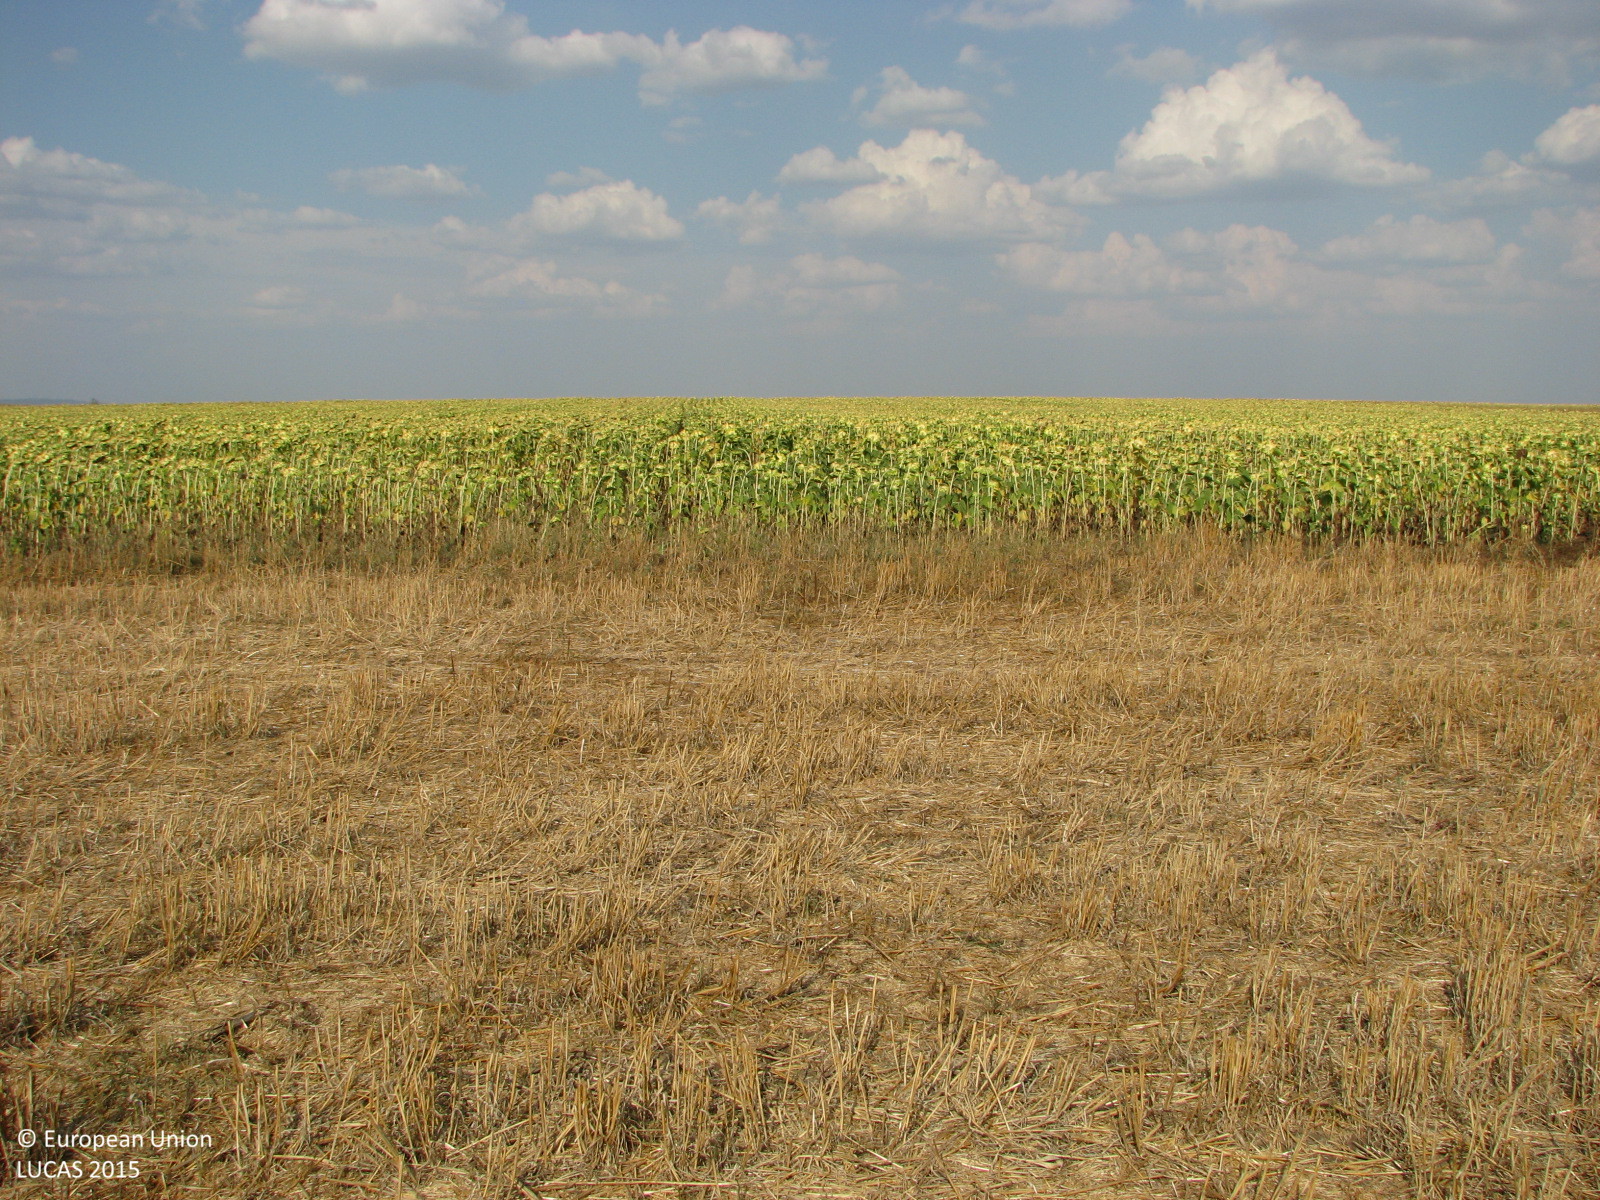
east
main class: Cropland
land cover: Common wheat
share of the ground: 25 - 50 %
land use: Agriculture (excluding fallow land and kitchen gardens)
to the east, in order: Common wheat; Grass margins; Sunflower; Grass margins; Common wheat
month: August
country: BG
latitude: 42.5608
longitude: 26.5998
